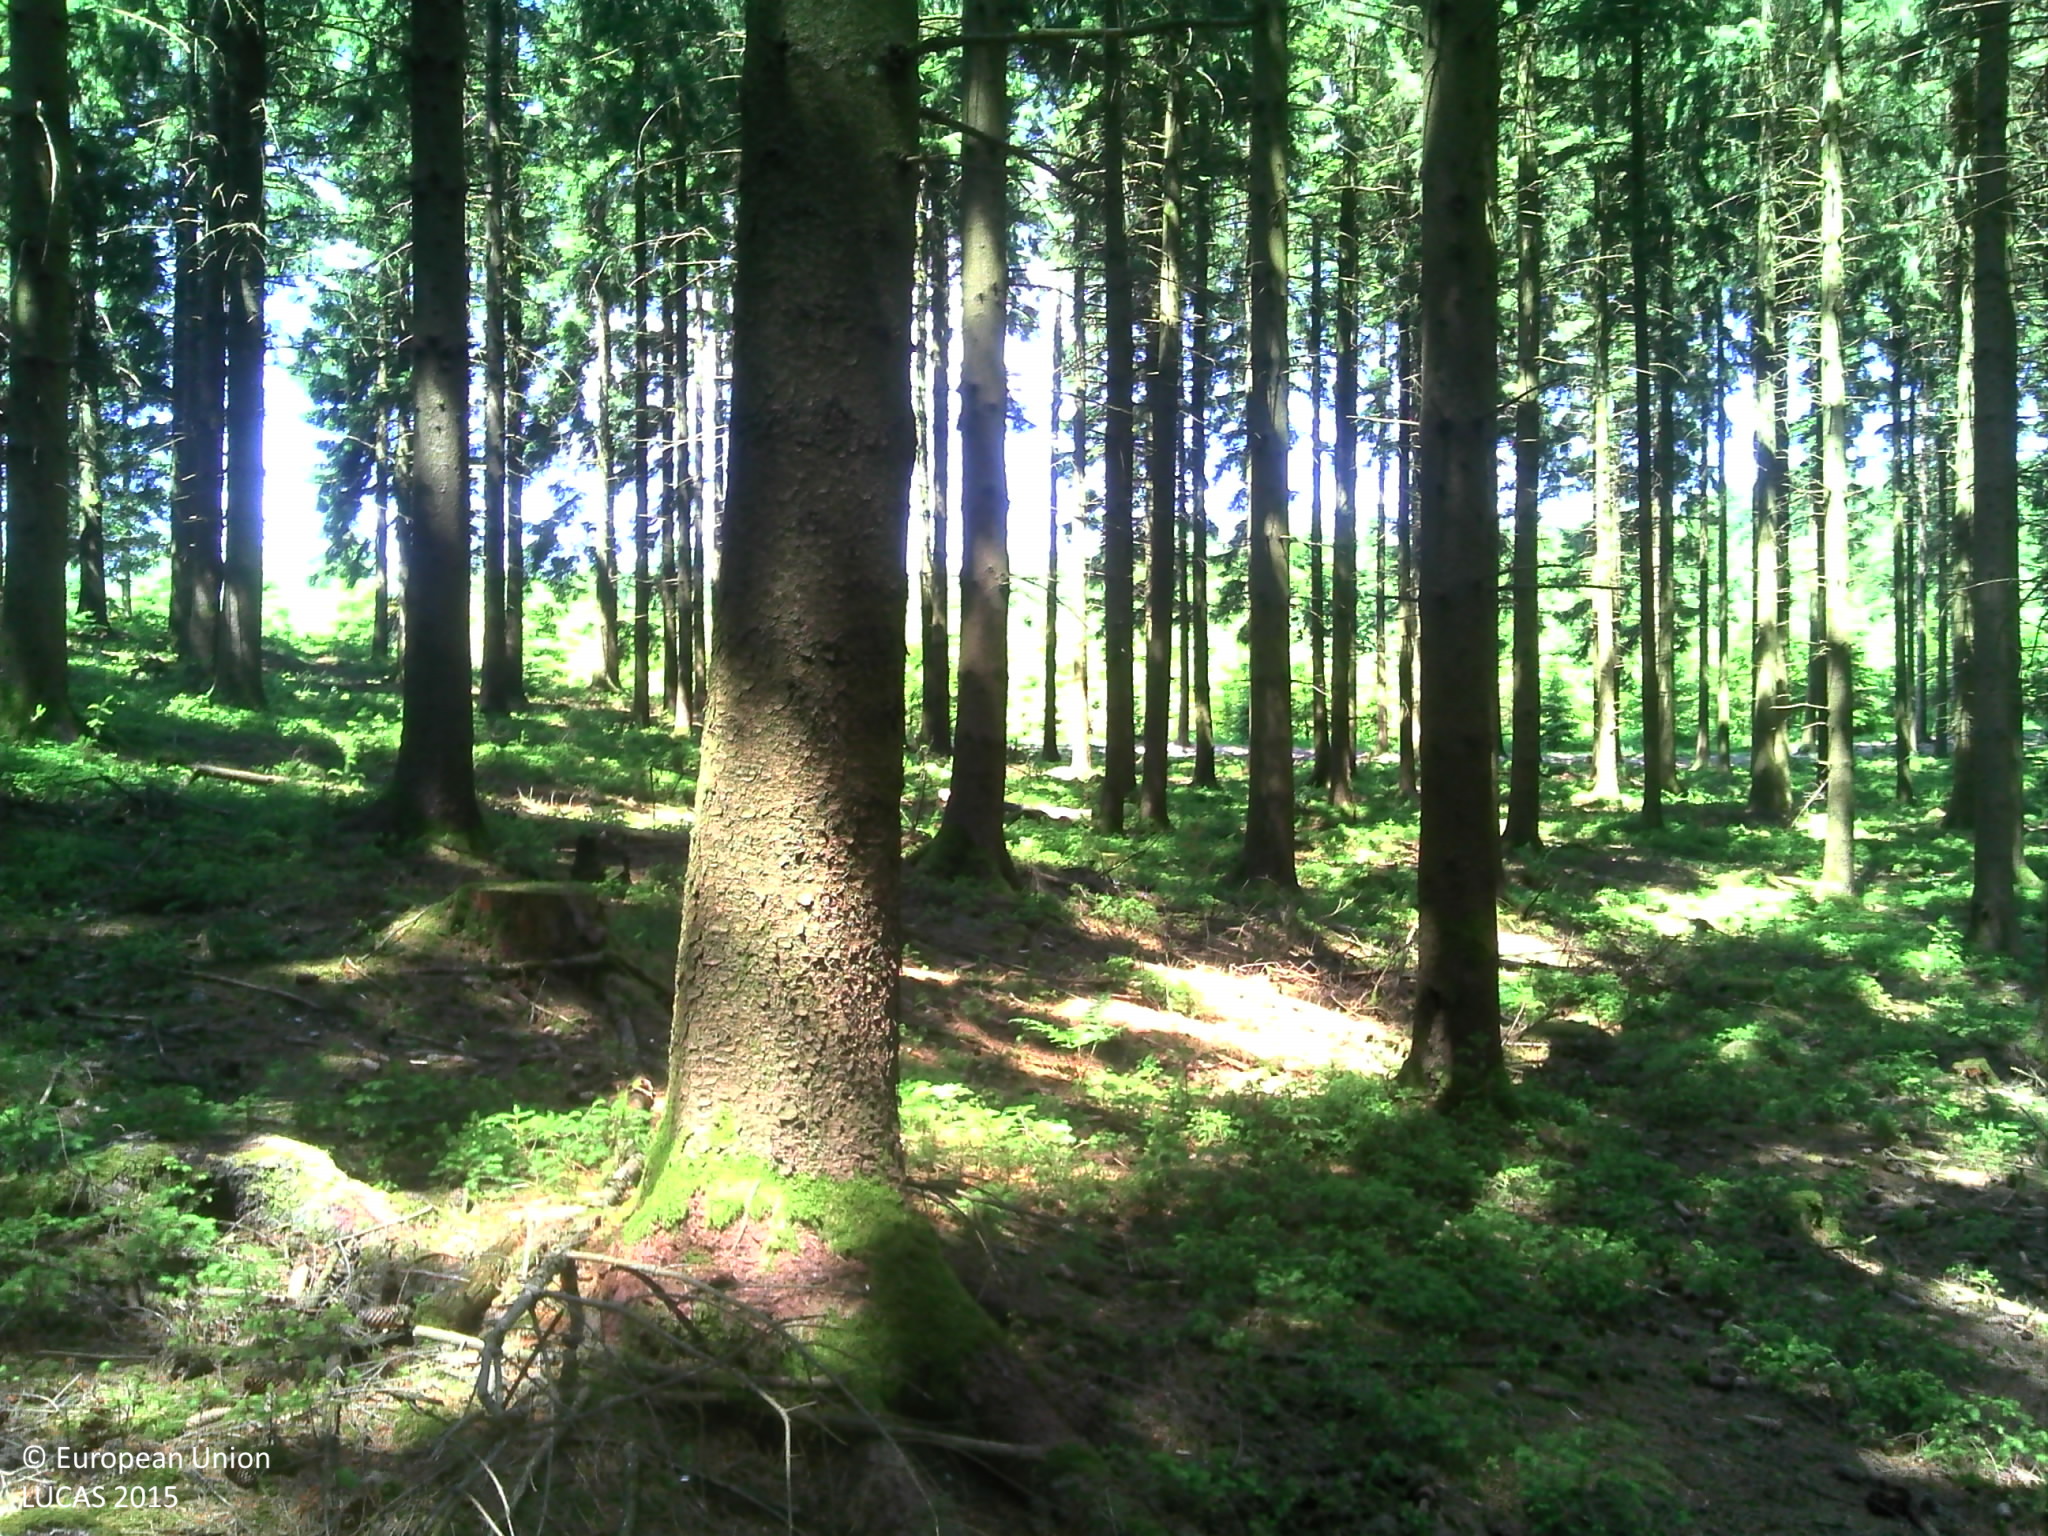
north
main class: Woodland
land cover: Spruce dominated coniferous woodland
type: alpine coniferous forest
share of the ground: > 75 %
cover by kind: coniferous forest trees 95 %, unconsolidated bare surface 5 %
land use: Forestry
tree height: > 5 m
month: June
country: BE
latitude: 49.9815
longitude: 4.5433
